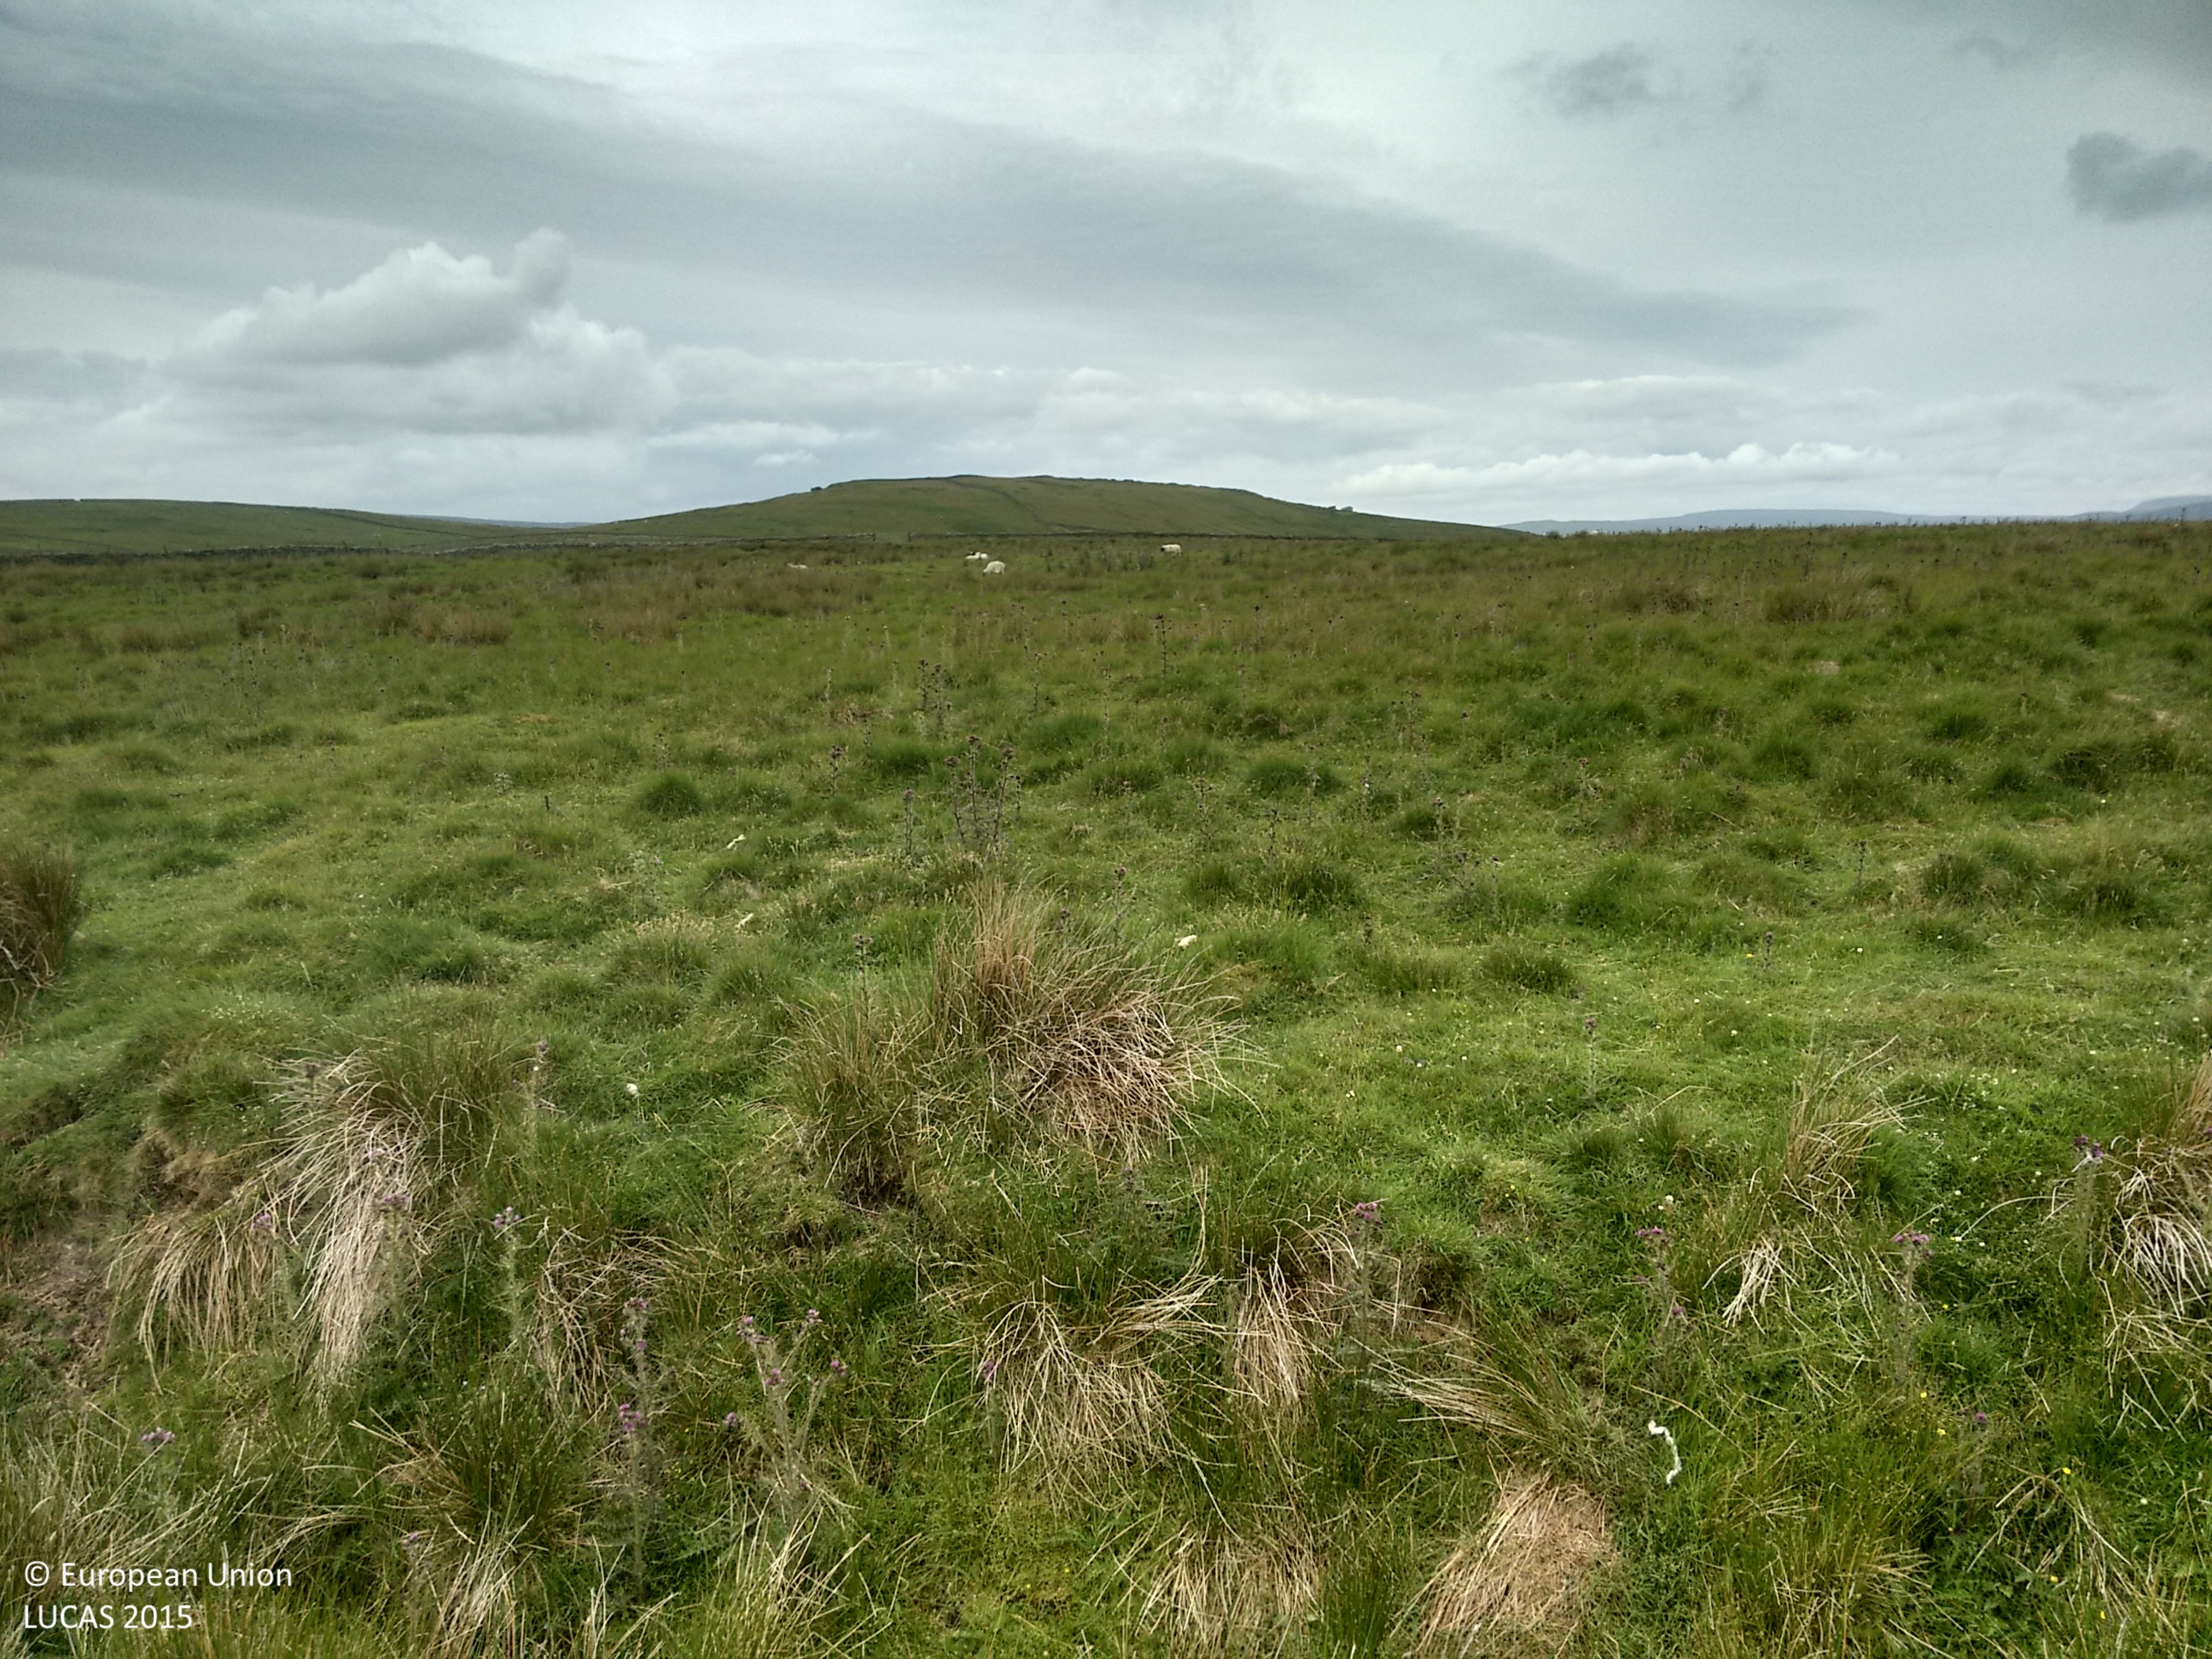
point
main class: Grassland
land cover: Grassland without tree/shrub cover
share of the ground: > 75 %
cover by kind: herbaceous plants 100 %
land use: Agriculture (excluding fallow land and kitchen gardens)
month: July
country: GB
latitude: 54.5745
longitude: -2.1081
